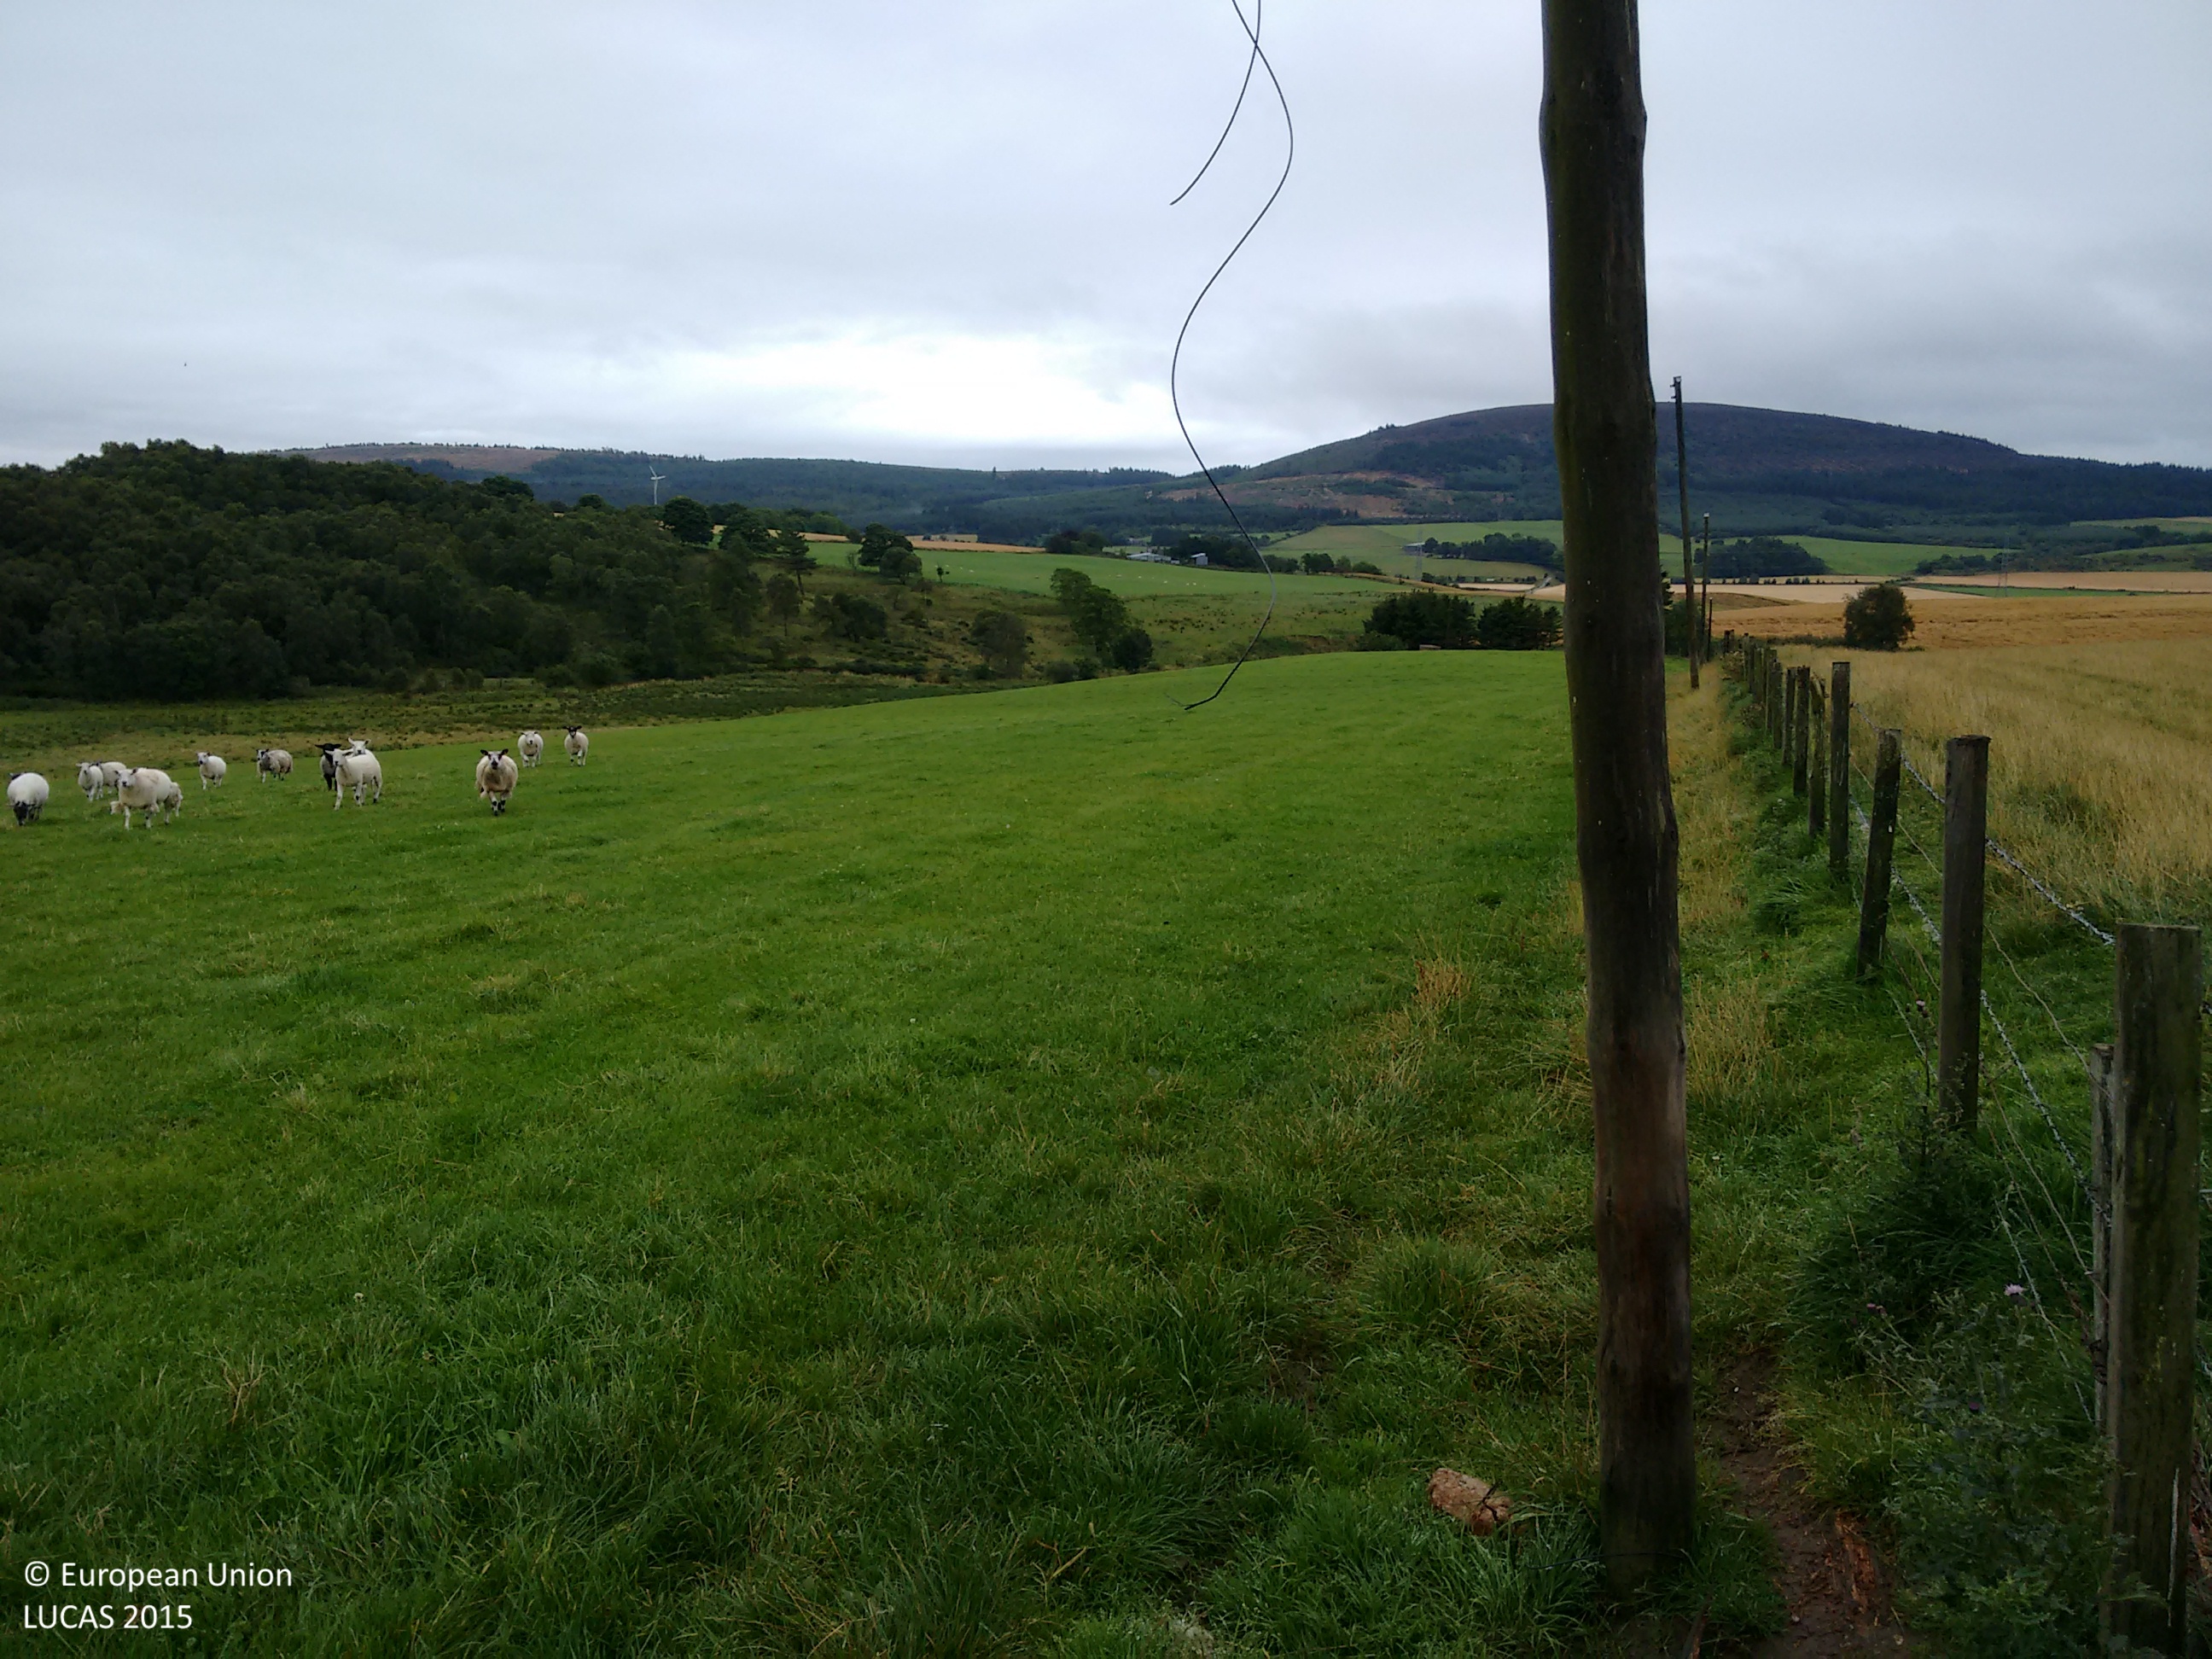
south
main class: Grassland
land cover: Grassland without tree/shrub cover
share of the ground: > 75 %
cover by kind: herbaceous plants 100 %
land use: Agriculture (excluding fallow land and kitchen gardens)
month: September
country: GB
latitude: 57.5600
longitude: -2.8789
